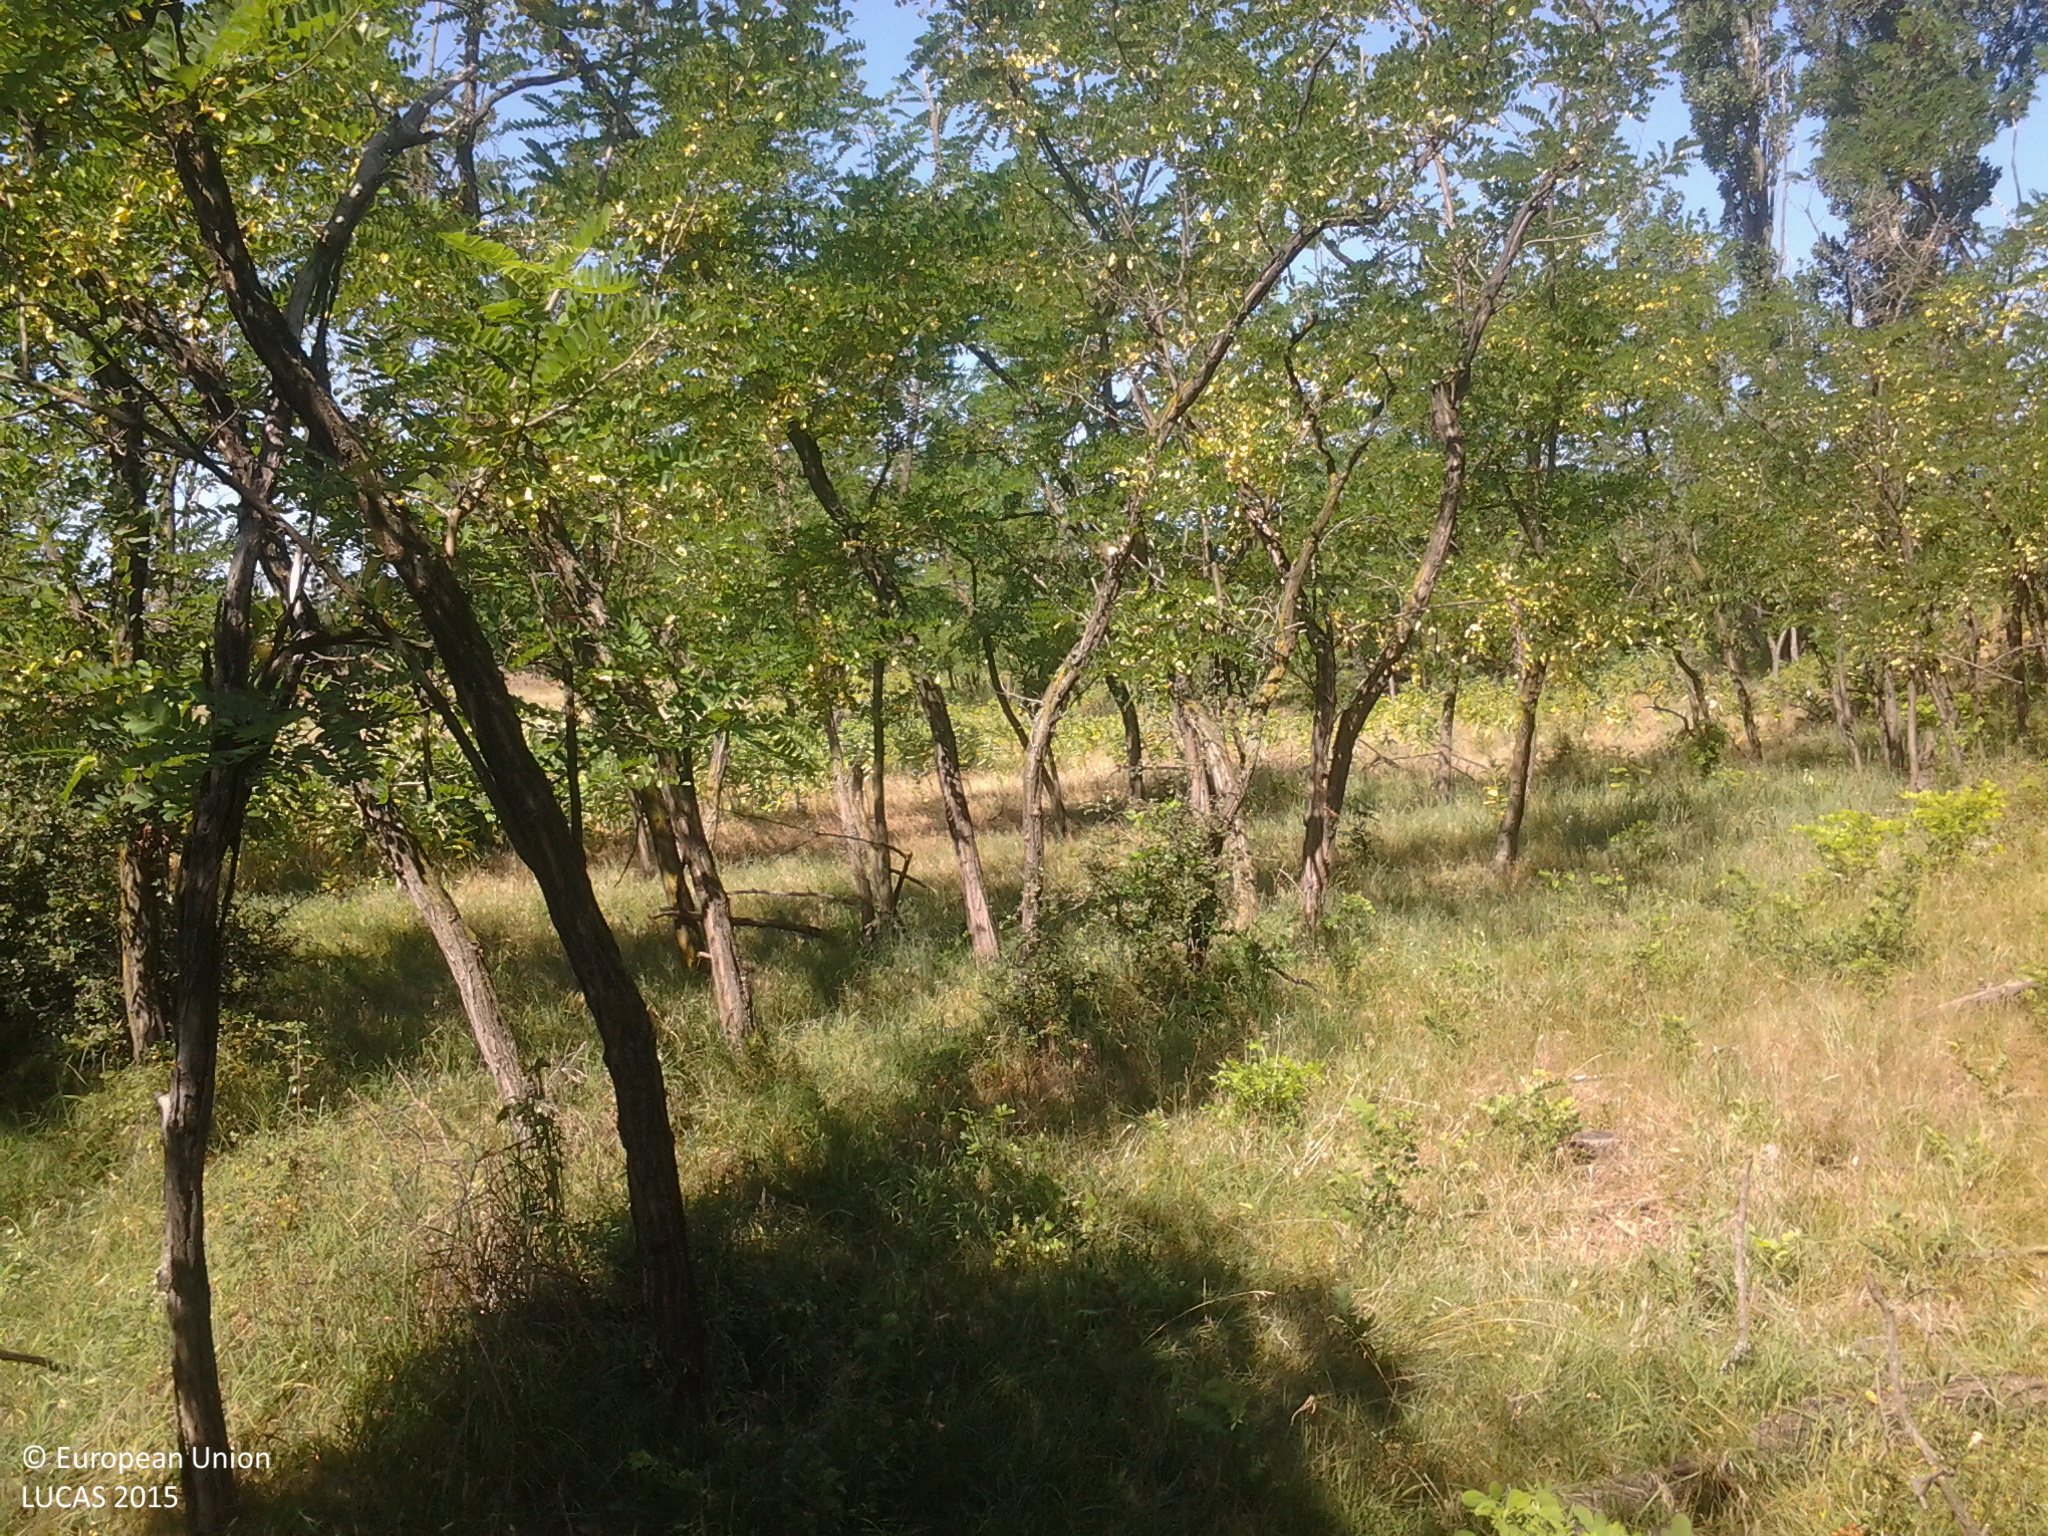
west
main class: Woodland
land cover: Broadleaved woodland
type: exotic forest
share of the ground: 50 - 75 %
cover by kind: broadleaved forest trees 70 %, herbaceous plants 30 %
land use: Forestry
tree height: > 5 m
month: July
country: HU
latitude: 46.5395
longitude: 19.5500
